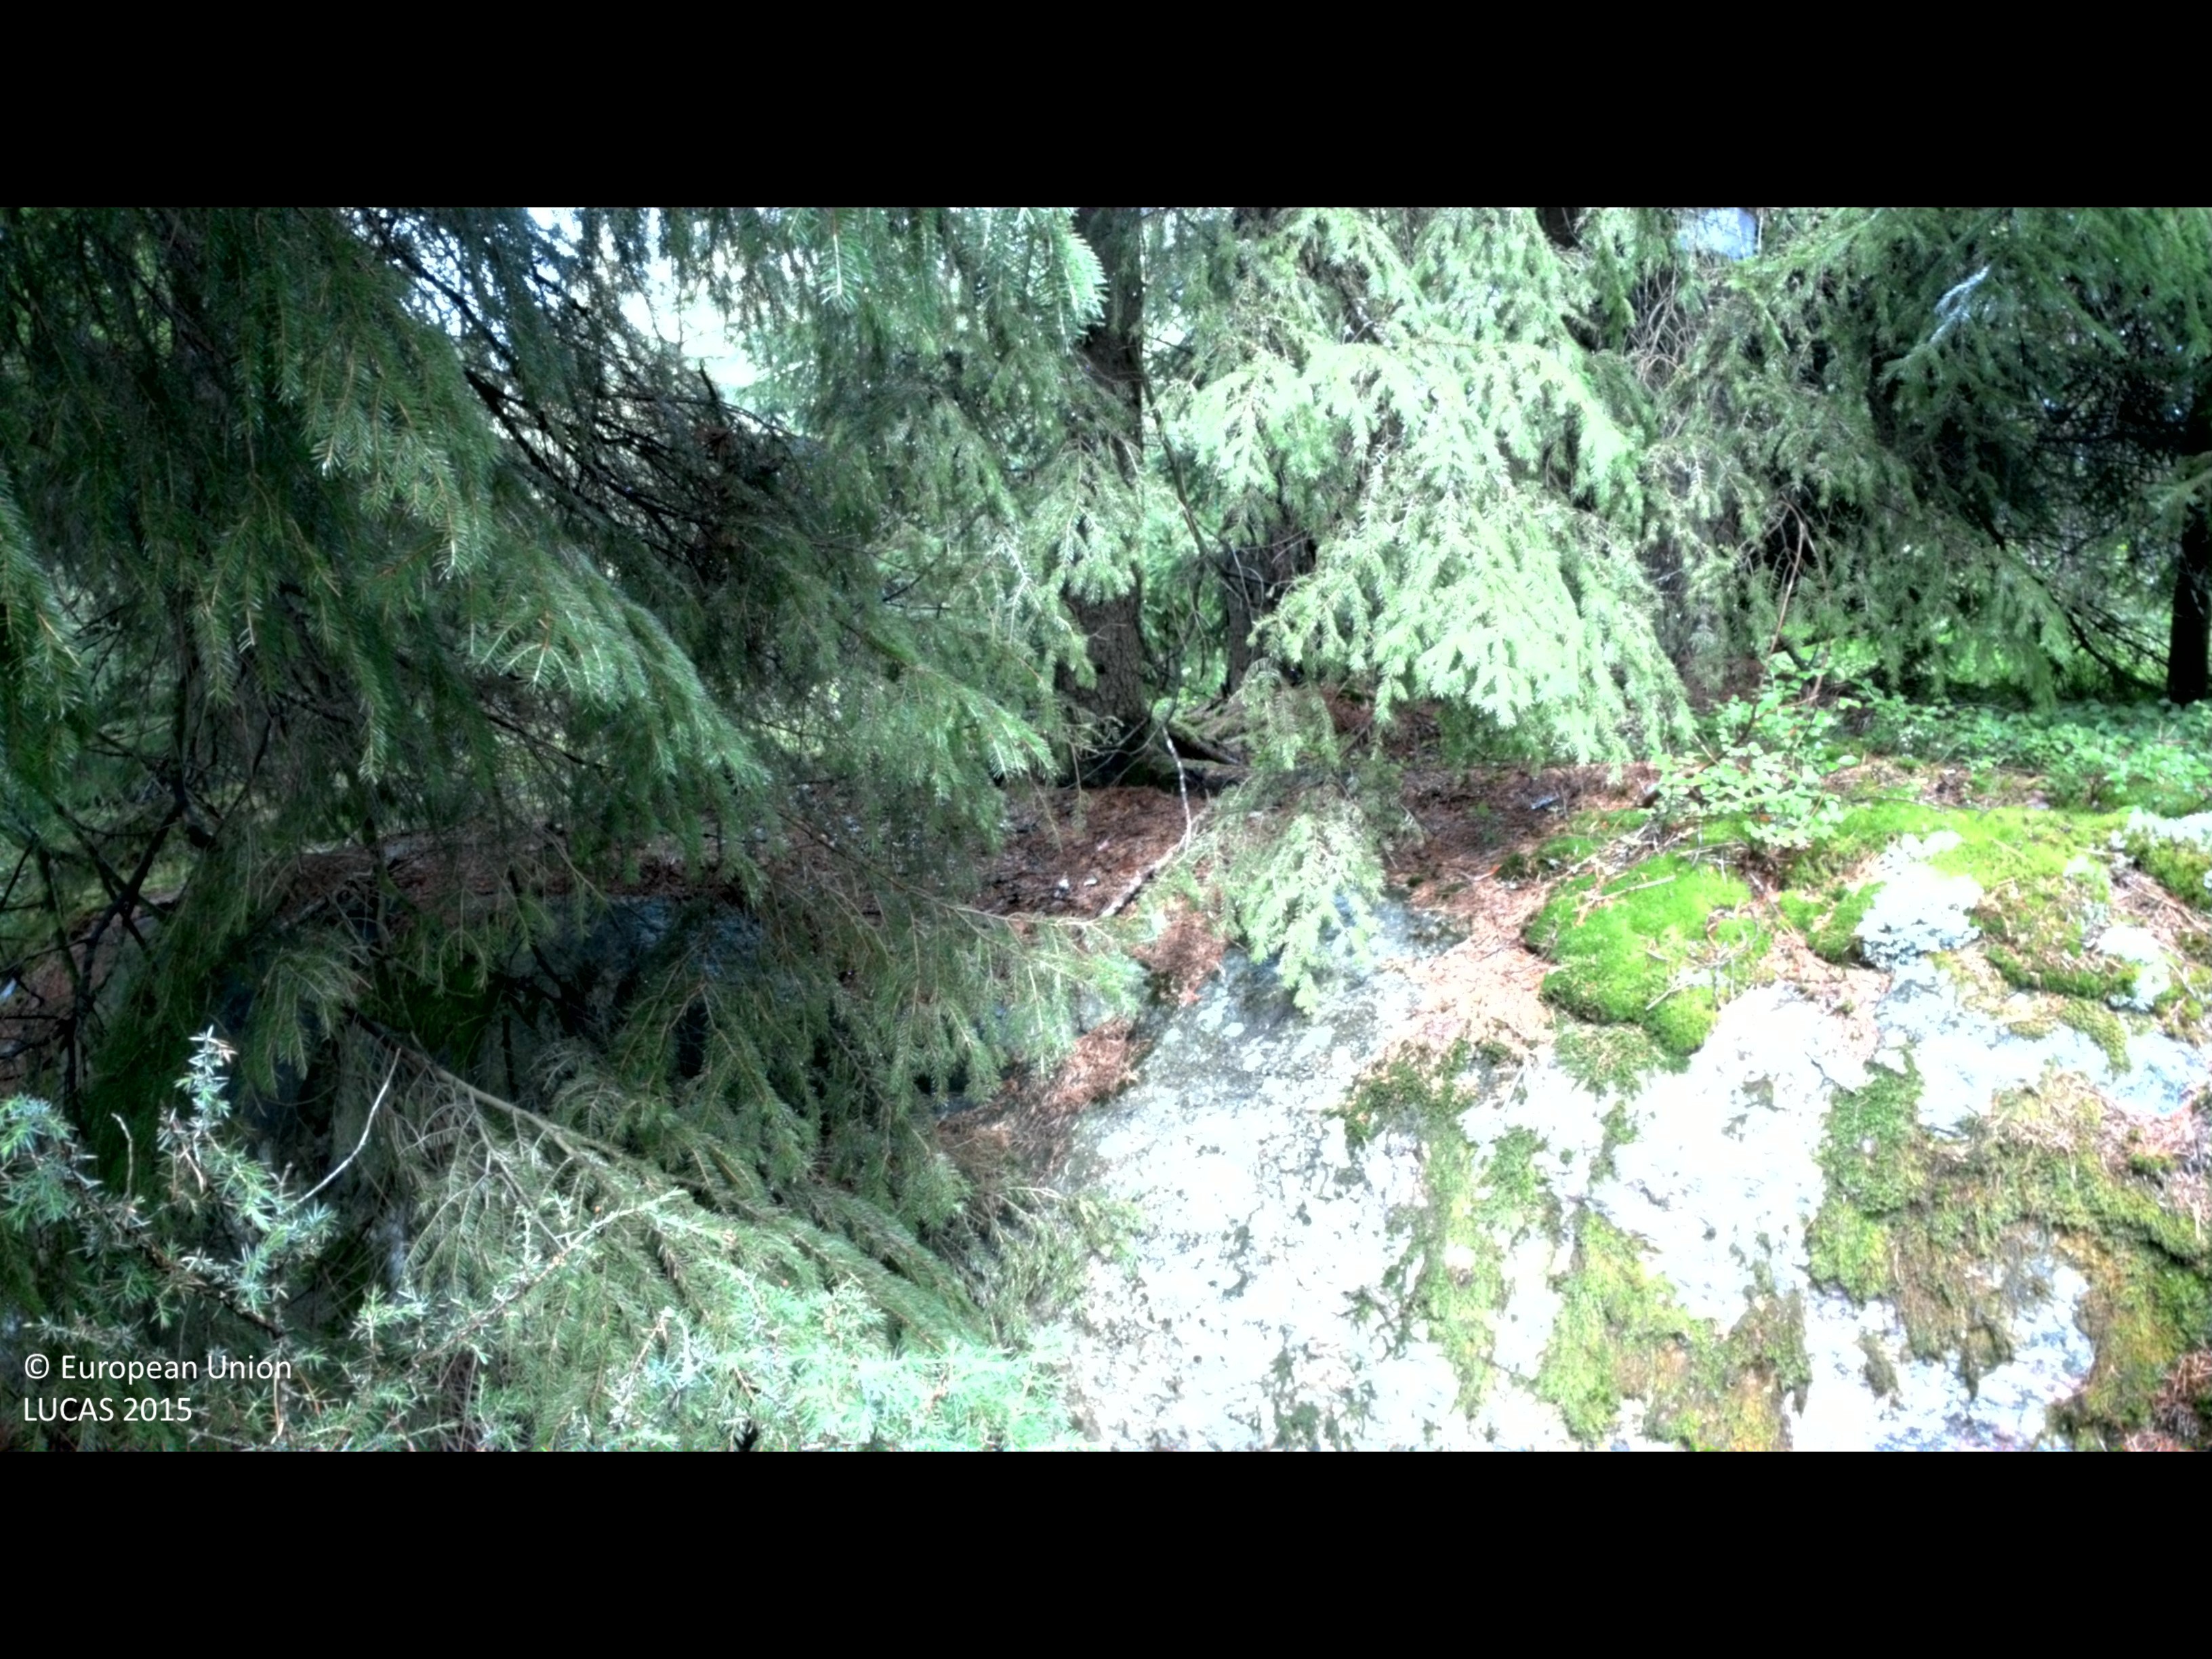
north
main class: Woodland
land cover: Spruce dominated coniferous woodland
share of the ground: 50 - 75 %
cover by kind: coniferous forest trees 55 %, shrubs 20 %, broadleaved forest trees 10 %, herbaceous plants 10 %, lichens and mosses 5 %
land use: Forestry
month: July
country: SE
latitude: 58.3815
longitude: 16.2379
